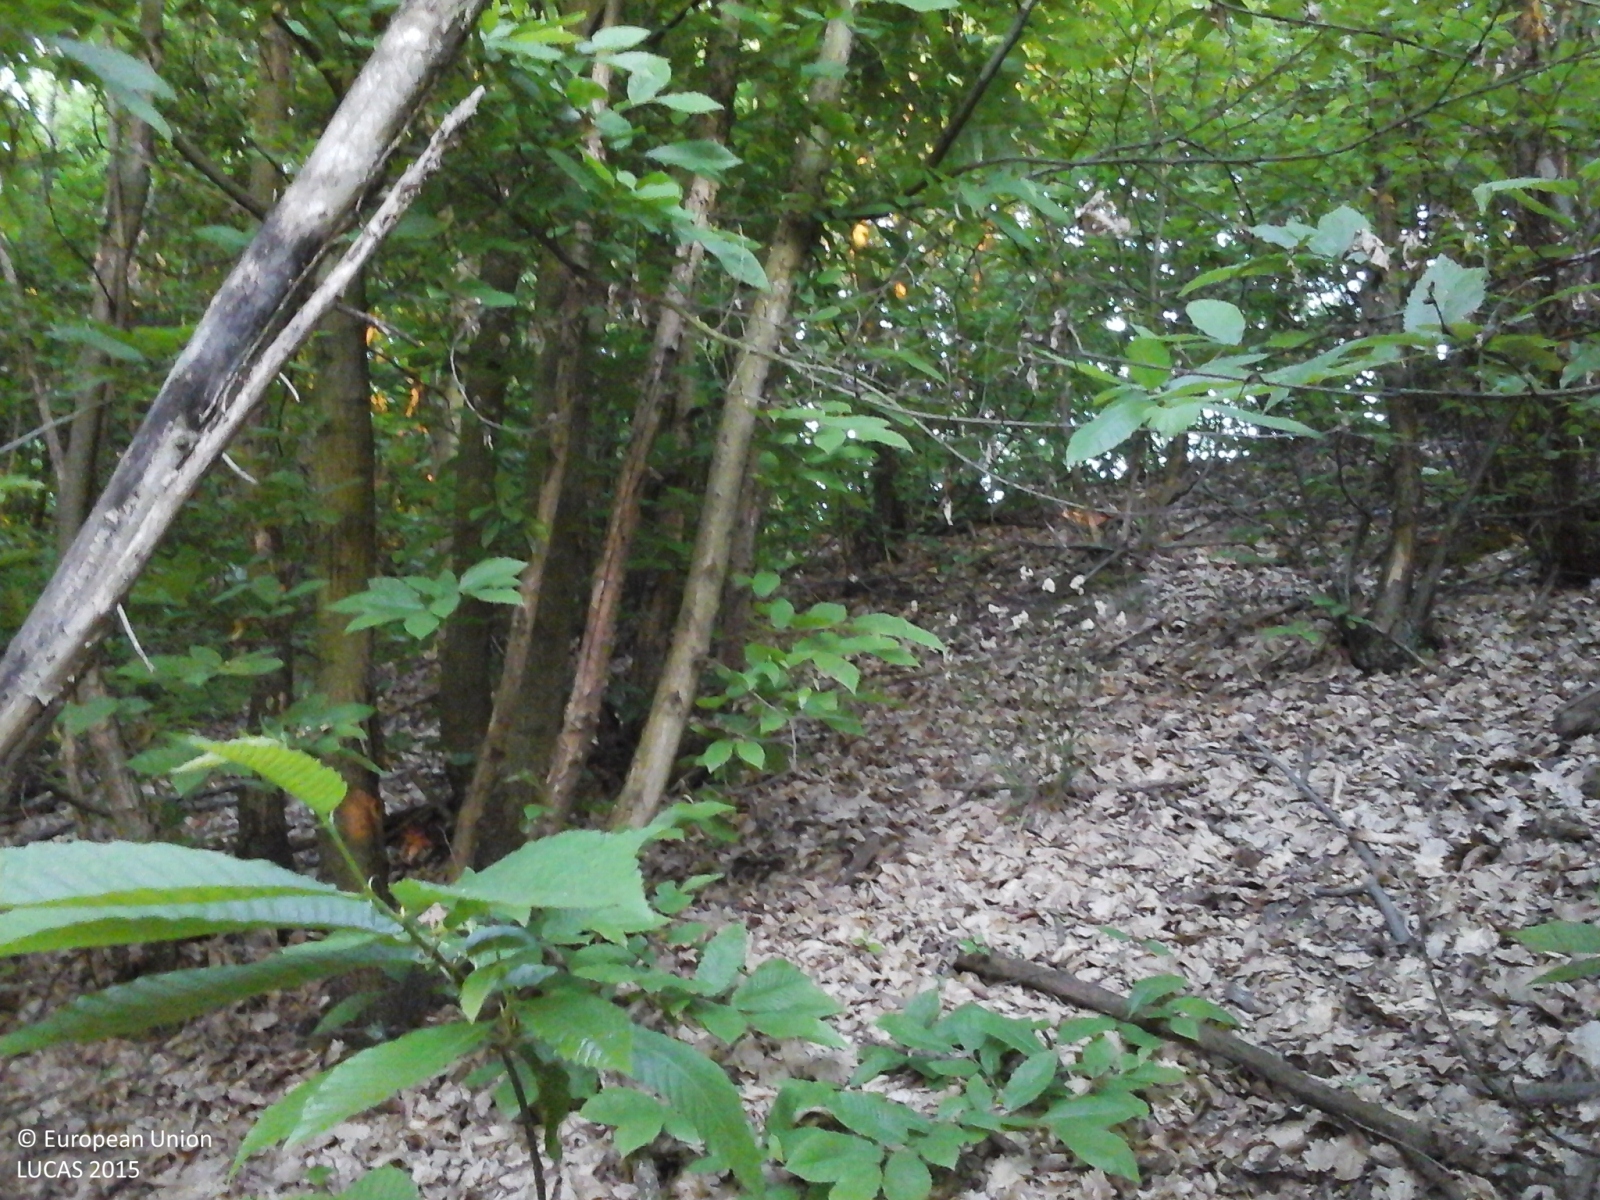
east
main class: Woodland
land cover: Broadleaved woodland
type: thermophilous deciduous forest
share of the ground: > 75 %
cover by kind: broadleaved forest trees 100 %
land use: Forestry
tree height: > 5 m
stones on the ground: < 10 %
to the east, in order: Broadleaved woodland
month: May
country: IT
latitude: 44.9467
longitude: 8.1151
